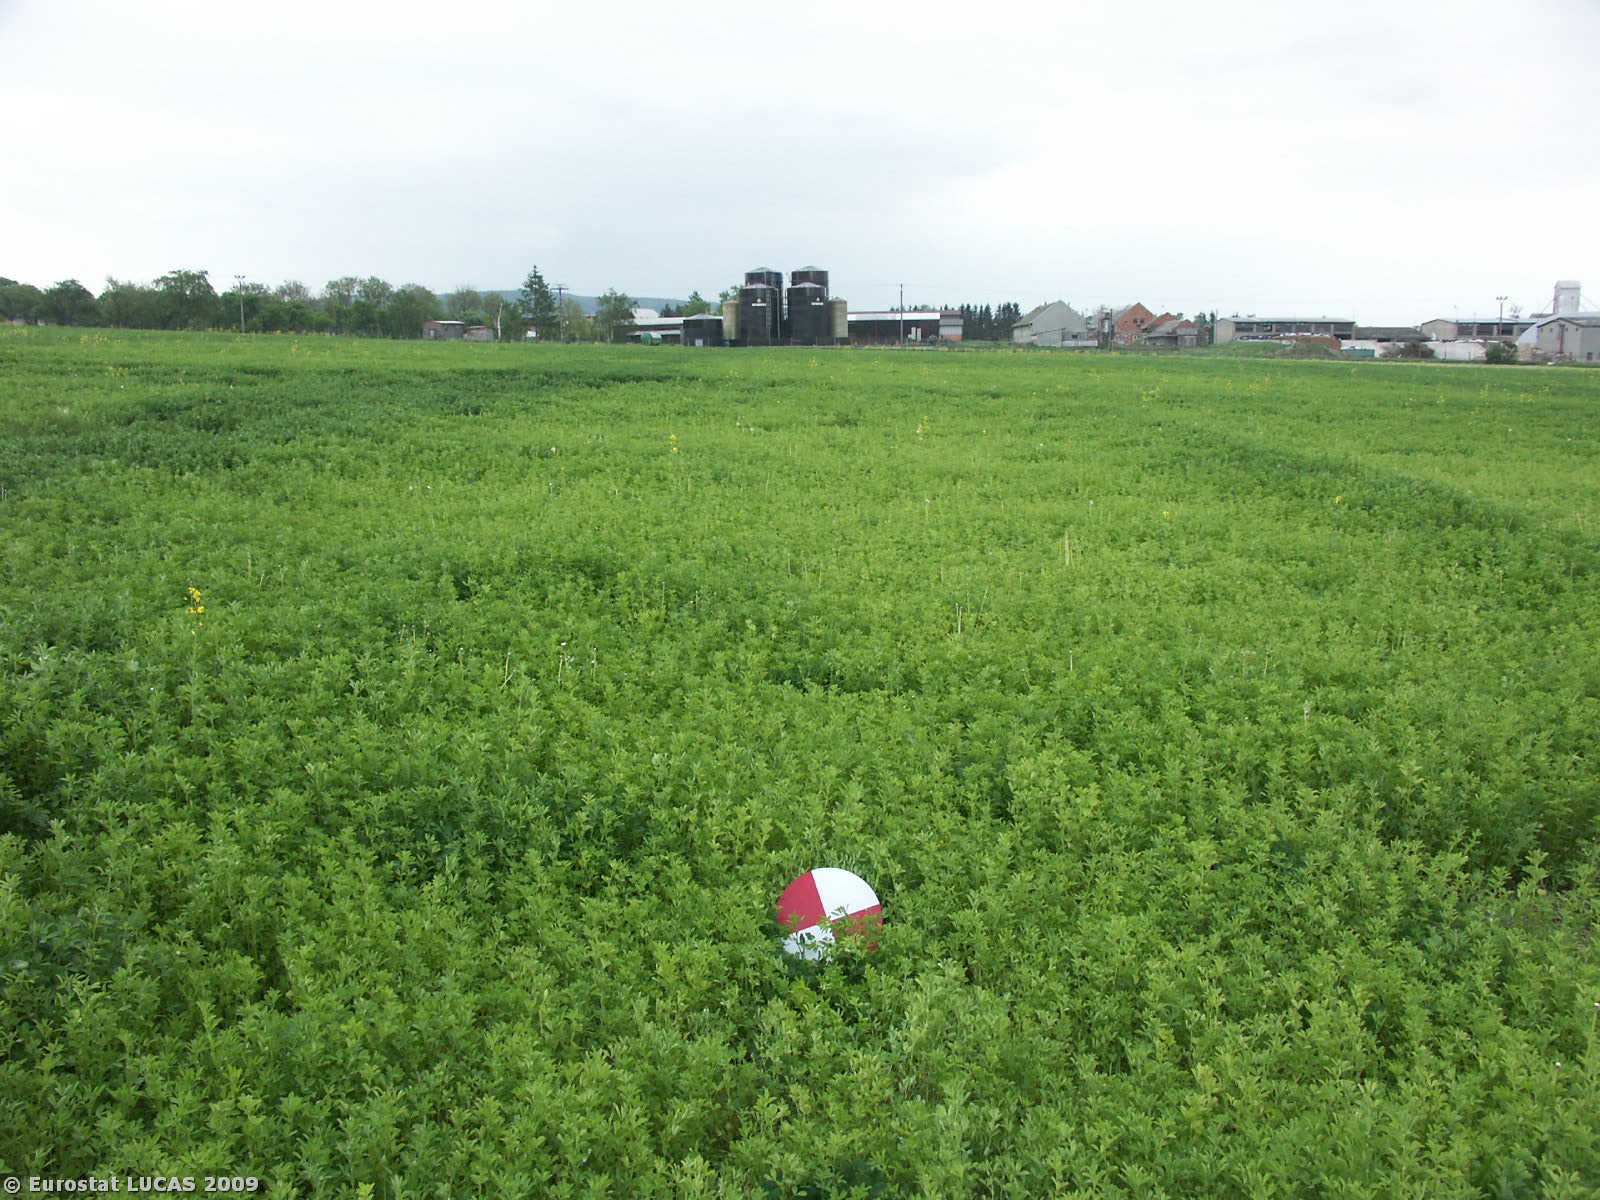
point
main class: Cropland
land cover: Lucerne
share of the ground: > 75 %
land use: Agriculture (excluding fallow land and kitchen gardens)
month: May
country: CZ
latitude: 49.6783
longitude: 17.3146
